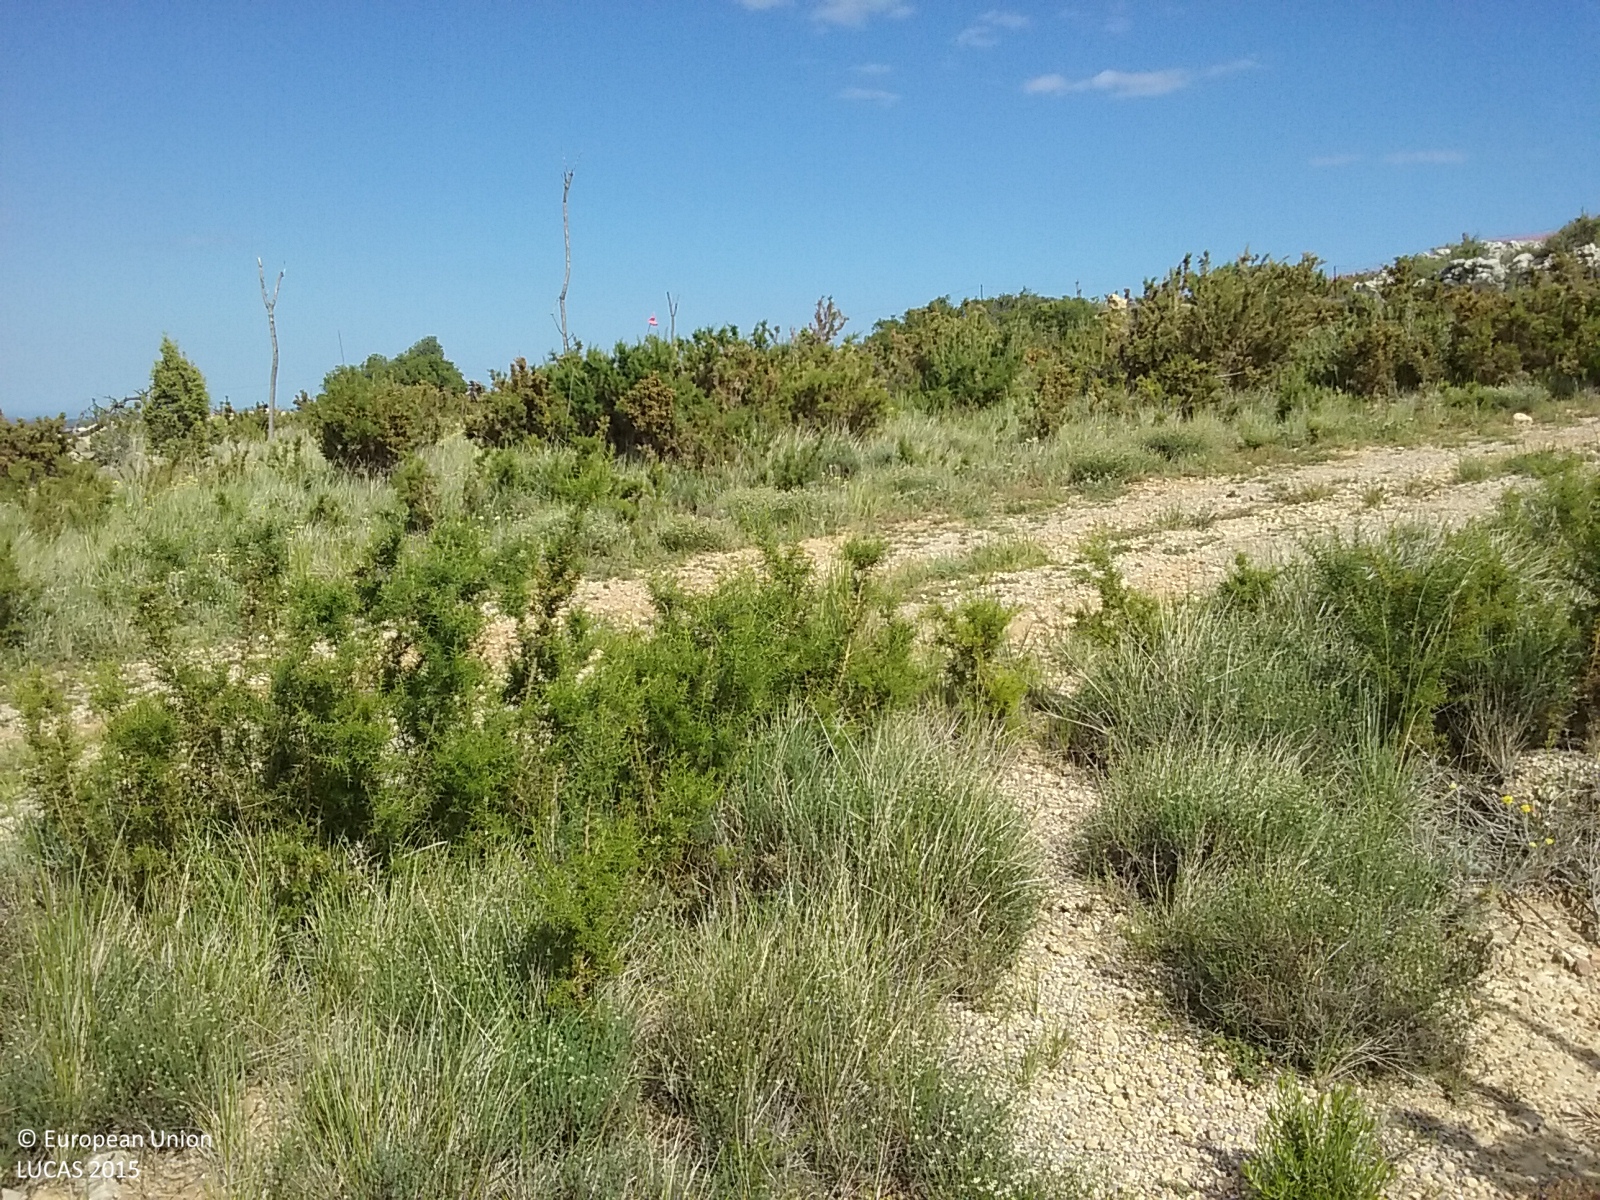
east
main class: Shrubland
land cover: Shrubland with sparse tree cover
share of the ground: > 75 %
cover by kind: shrubs 70 %, herbaceous plants 20 %, coniferous forest trees 5 %
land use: Semi-natural and natural areas not in use
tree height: < 5 m
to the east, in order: Shrubland with sparse tree cover; Grassland without tree/shrub cover; Tracks; Shrubland with sparse tree cover; Dry stone walls; Grassland without tree/shrub cover; Tracks; Fences; Shrubland with sparse tree cover; Dry stone walls; Shrubland with sparse tree cover; Dry stone walls; Shrubland with sparse tree cover; Paved roads, cycling and walking lanes; Fences; Shrubland with sparse tree cover; Dry stone walls; Shrubland with sparse tree cover; Dry stone walls; Shrubland with sparse tree cover; Tracks; Shrubland with sparse tree cover; Nuts trees; Shrubland with sparse tree cover; Nuts trees; Dry stone walls; Nuts trees
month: May
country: ES
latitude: 40.3430
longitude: 0.0483
